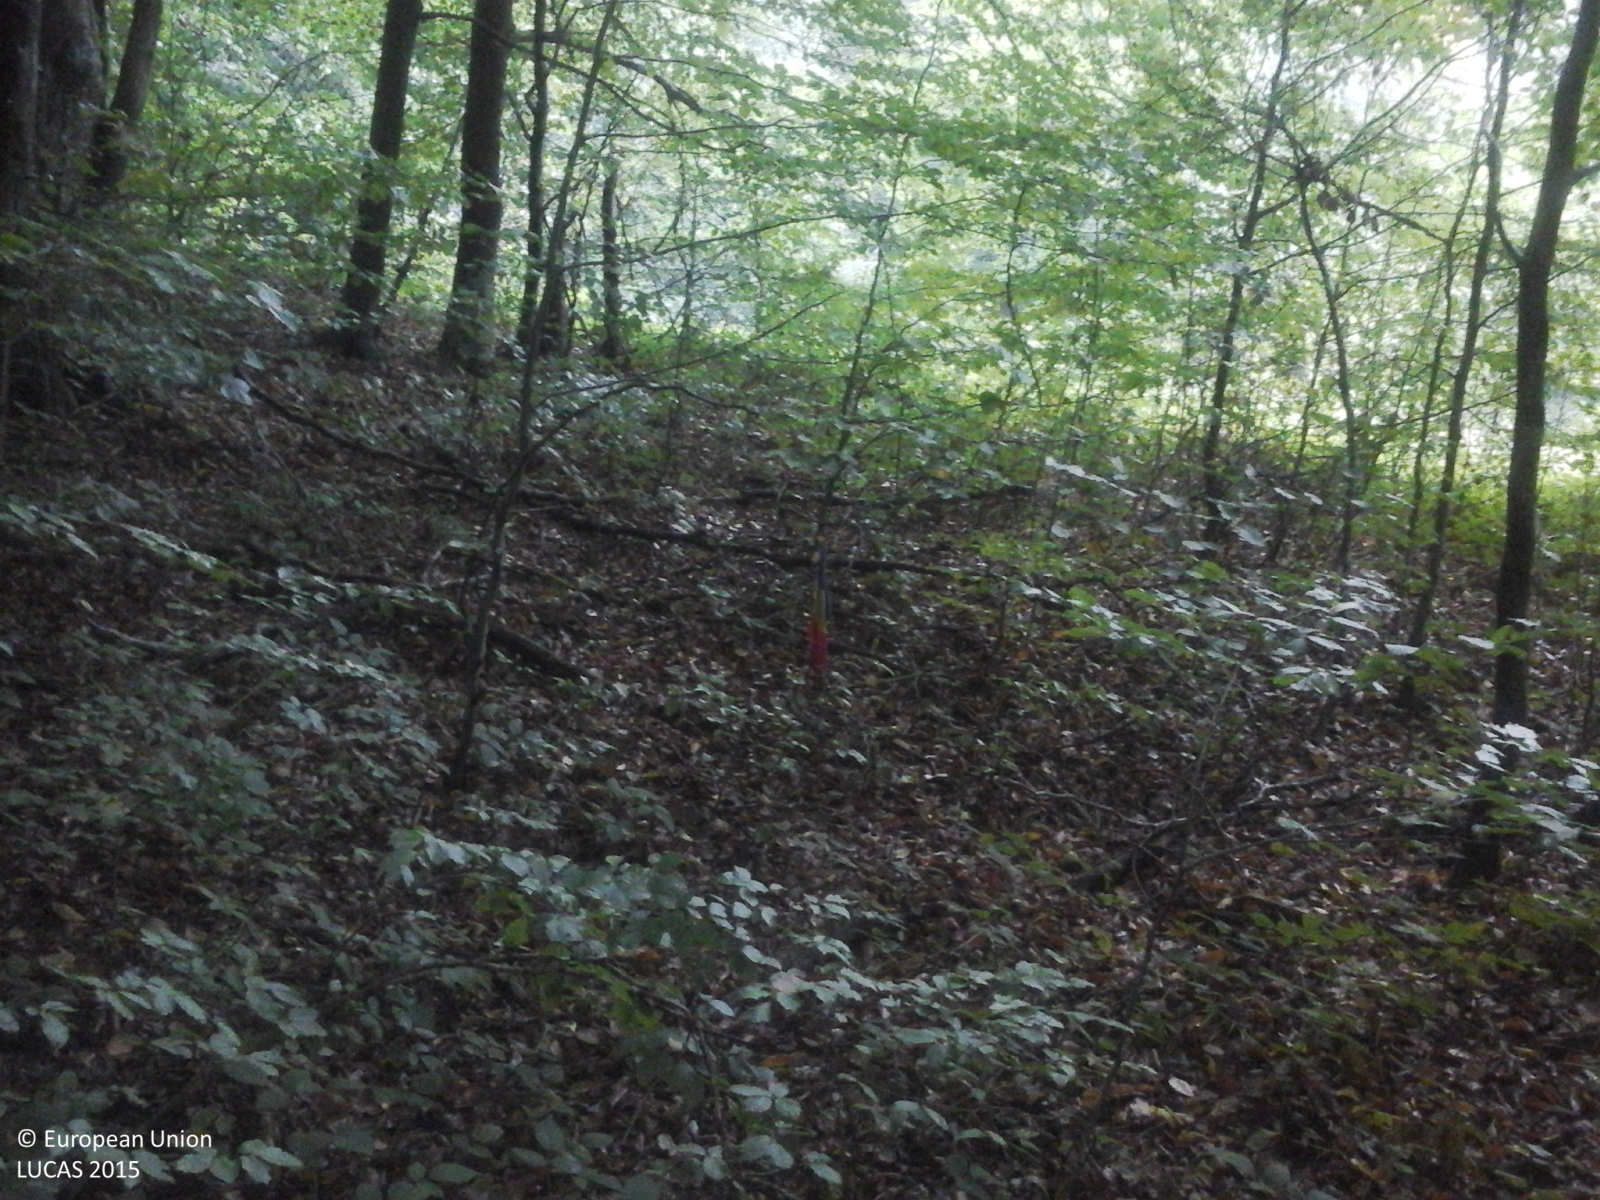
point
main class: Woodland
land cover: Broadleaved woodland
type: beech forest
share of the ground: > 75 %
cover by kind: broadleaved forest trees 100 %
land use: Forestry
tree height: > 5 m
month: August
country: RO
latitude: 44.7857
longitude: 21.7981
